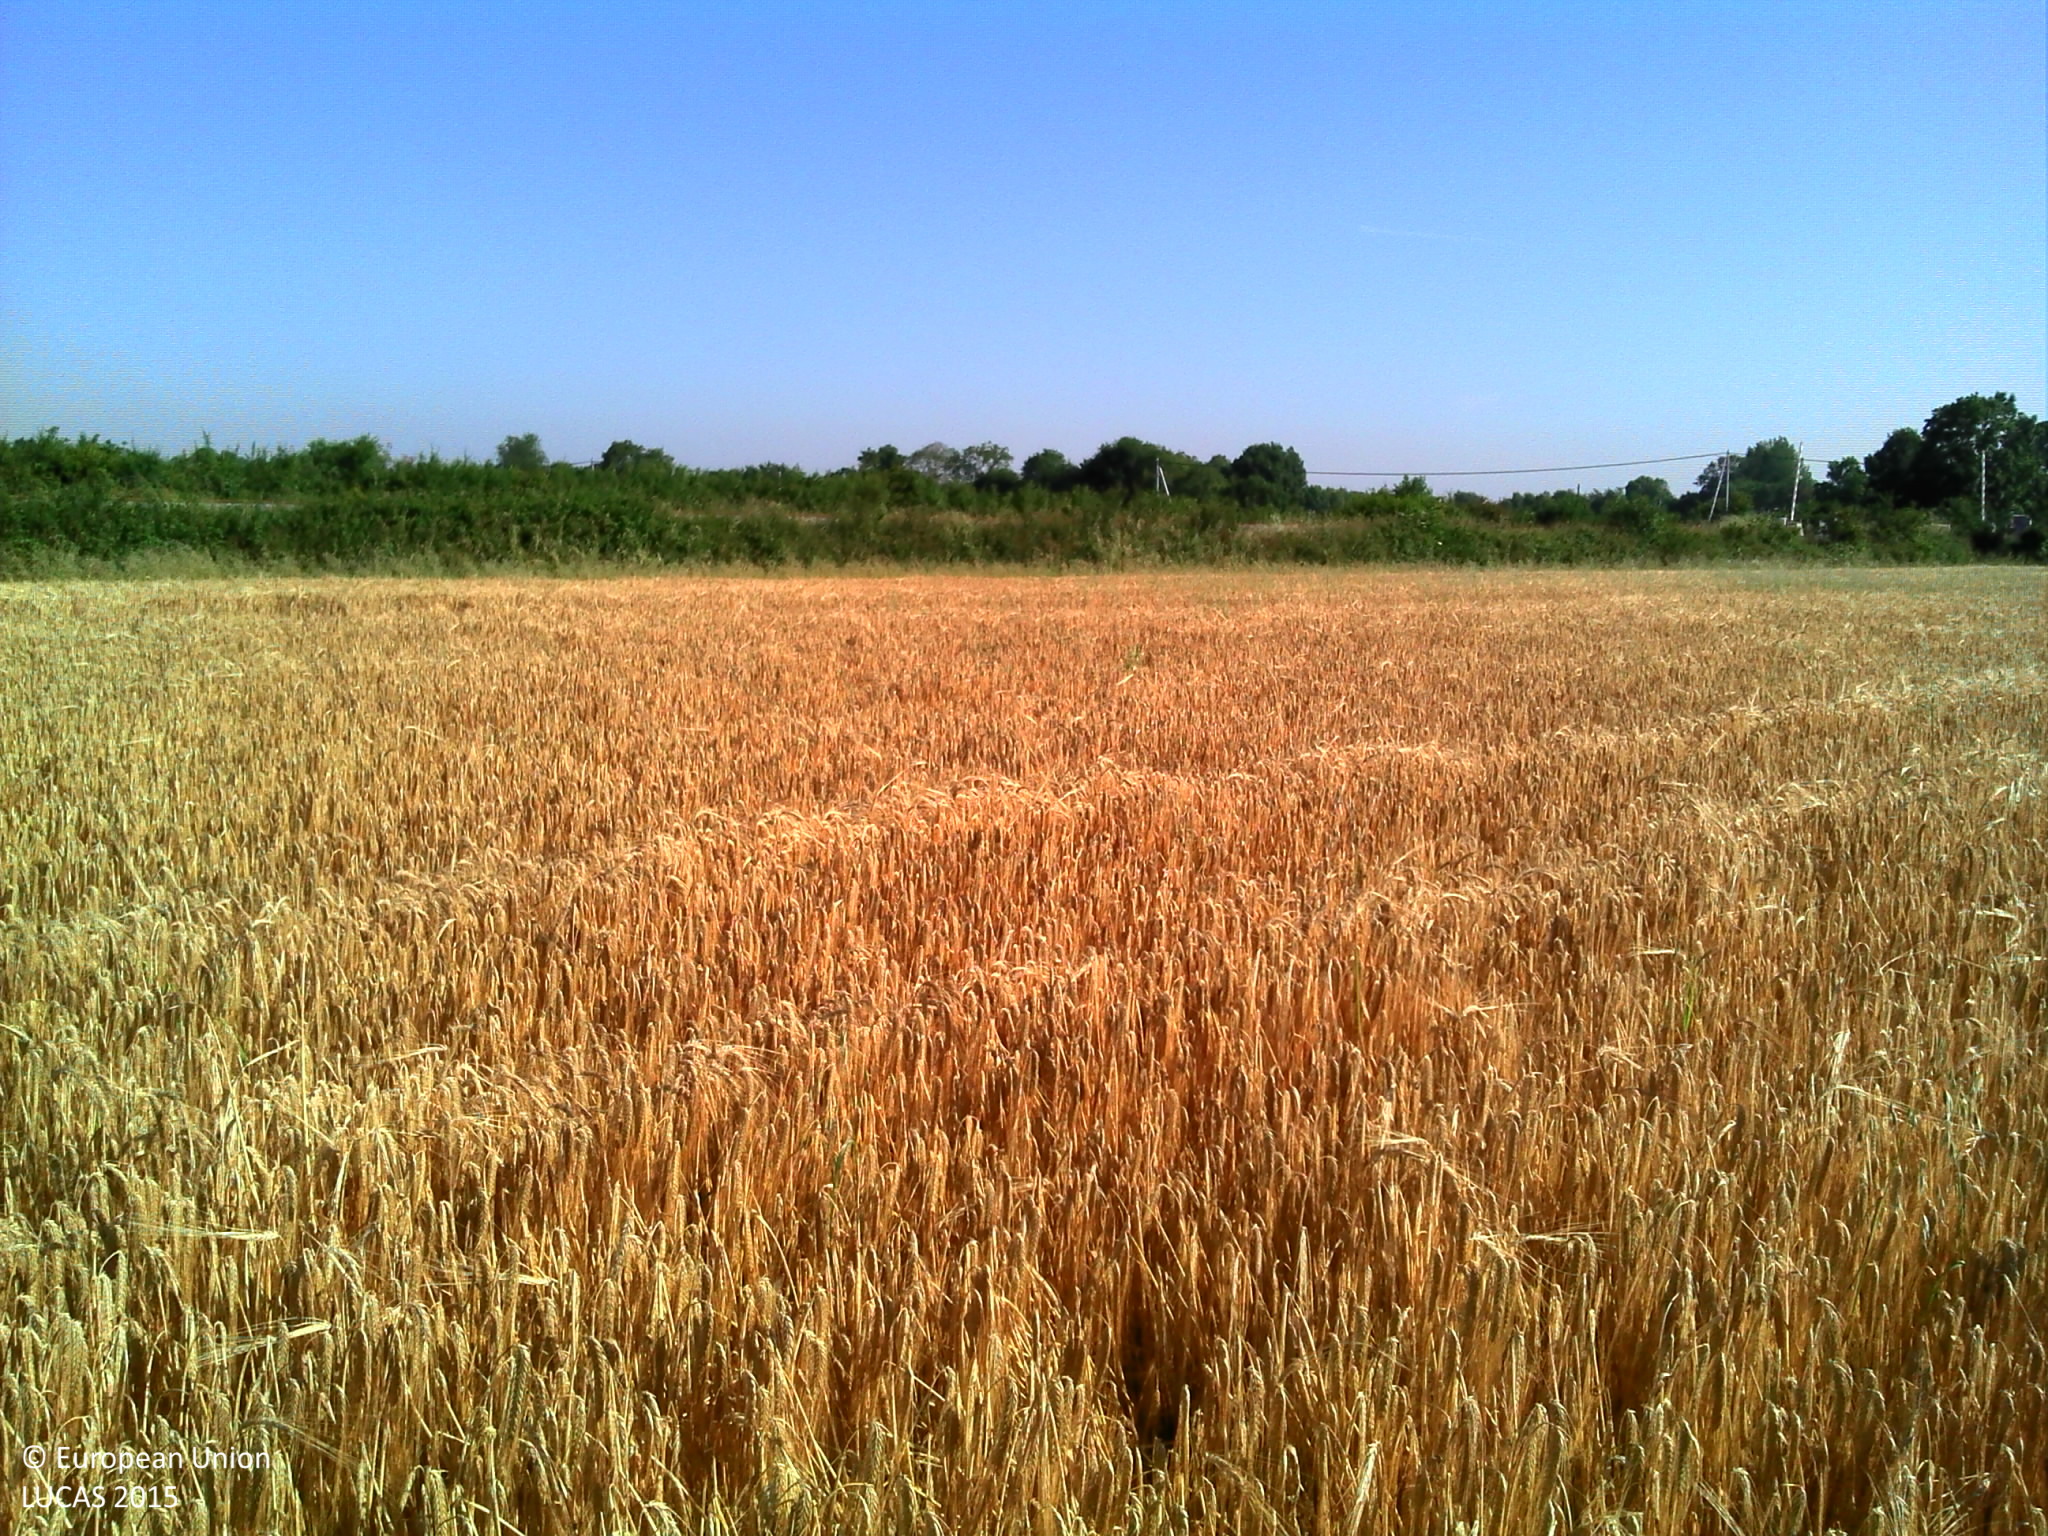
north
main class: Cropland
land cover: Barley
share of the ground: > 75 %
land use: Agriculture (excluding fallow land and kitchen gardens)
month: June
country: FR
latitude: 46.9653
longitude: -1.8335
